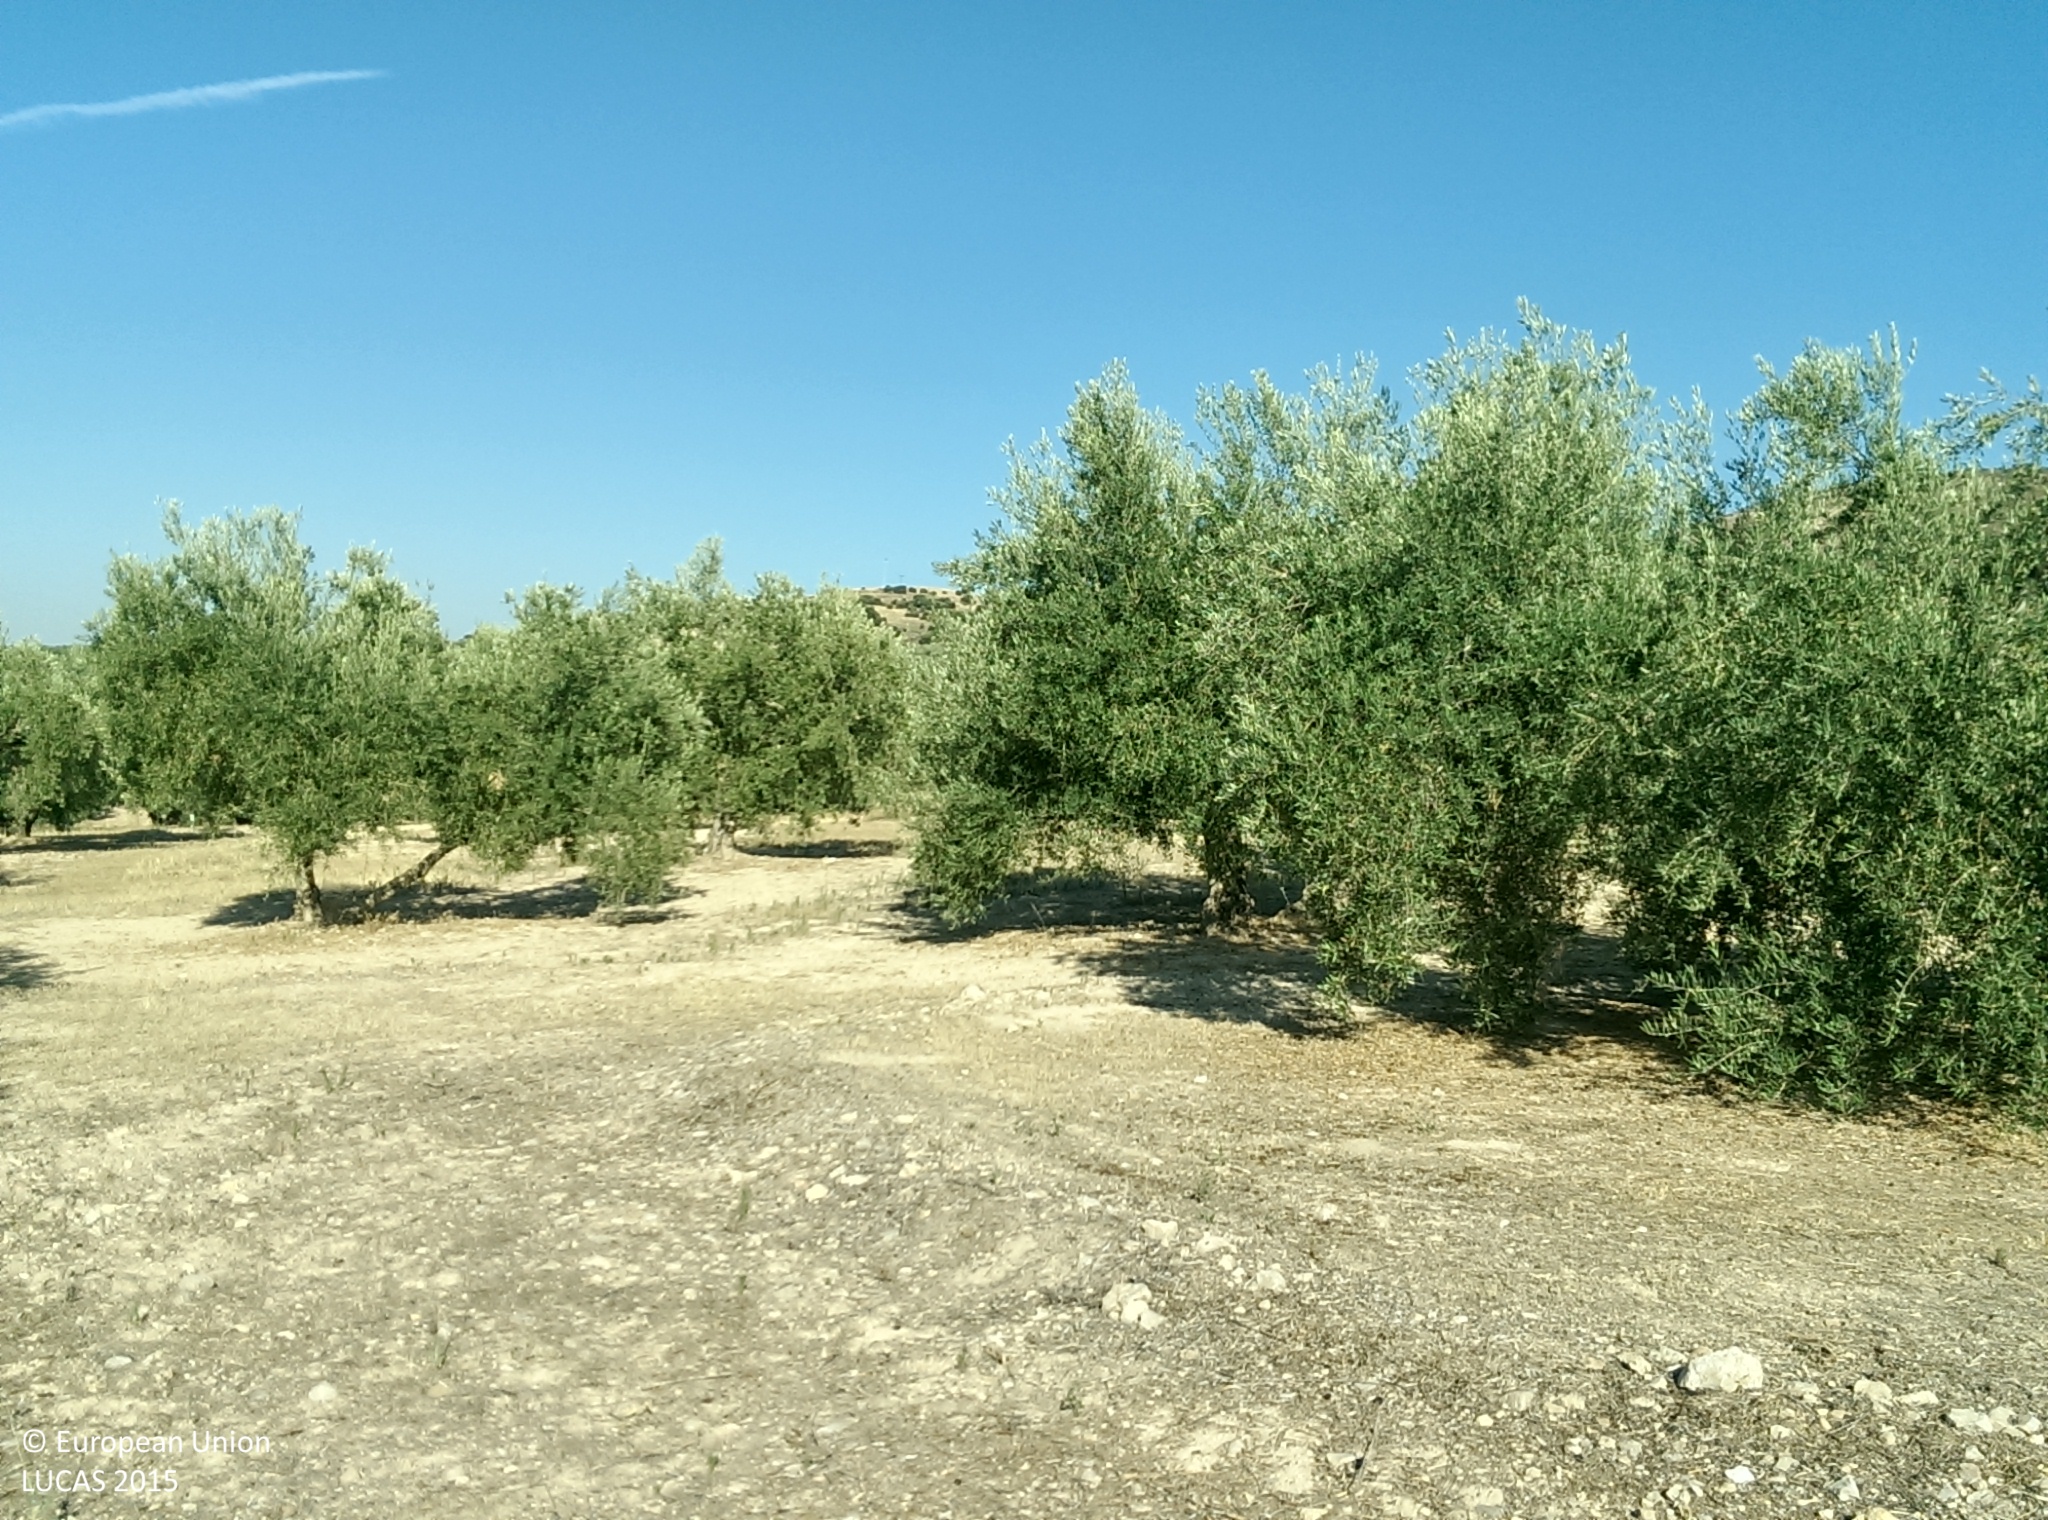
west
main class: Cropland
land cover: Olive groves
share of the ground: 25 - 50 %
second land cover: Other bare soil
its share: > 75 %
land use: Agriculture (excluding fallow land and kitchen gardens)
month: July
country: ES
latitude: 37.3344
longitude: -3.7289
